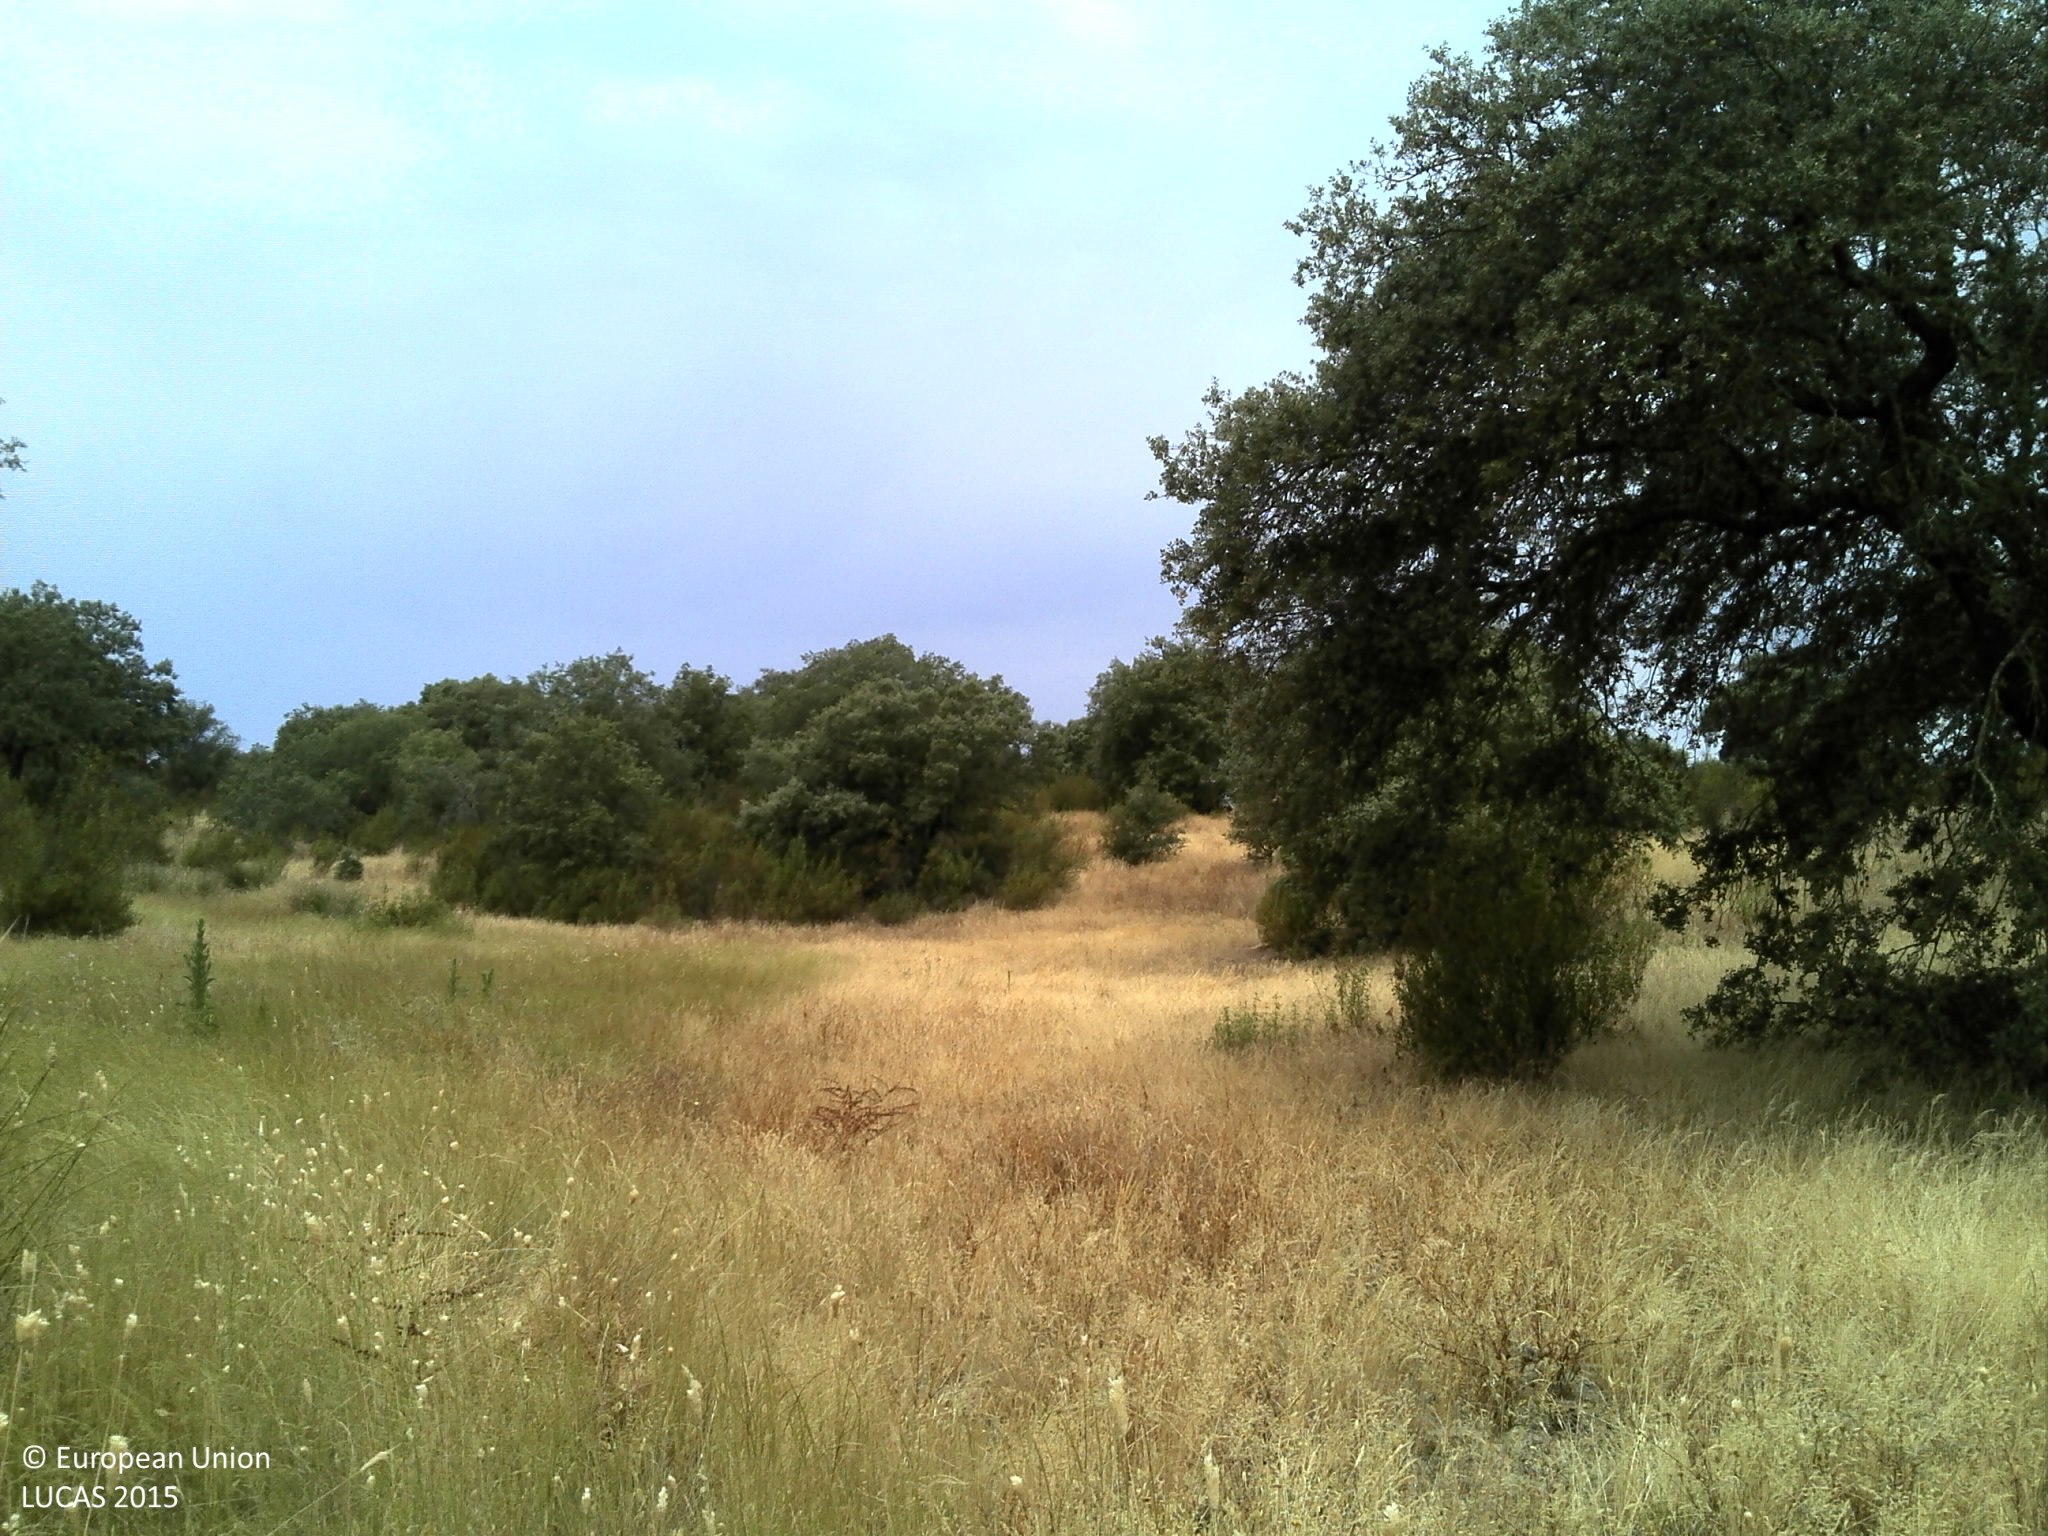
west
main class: Woodland
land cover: Broadleaved woodland
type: broadleaved evergreen forest
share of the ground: 10 - 25 %
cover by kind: shrubs 30 %, herbaceous plants 30 %, broadleaved forest trees 20 %, unconsolidated bare surface 20 %
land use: Forestry
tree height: > 5 m
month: June
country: PT
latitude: 38.5665
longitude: -7.8150
